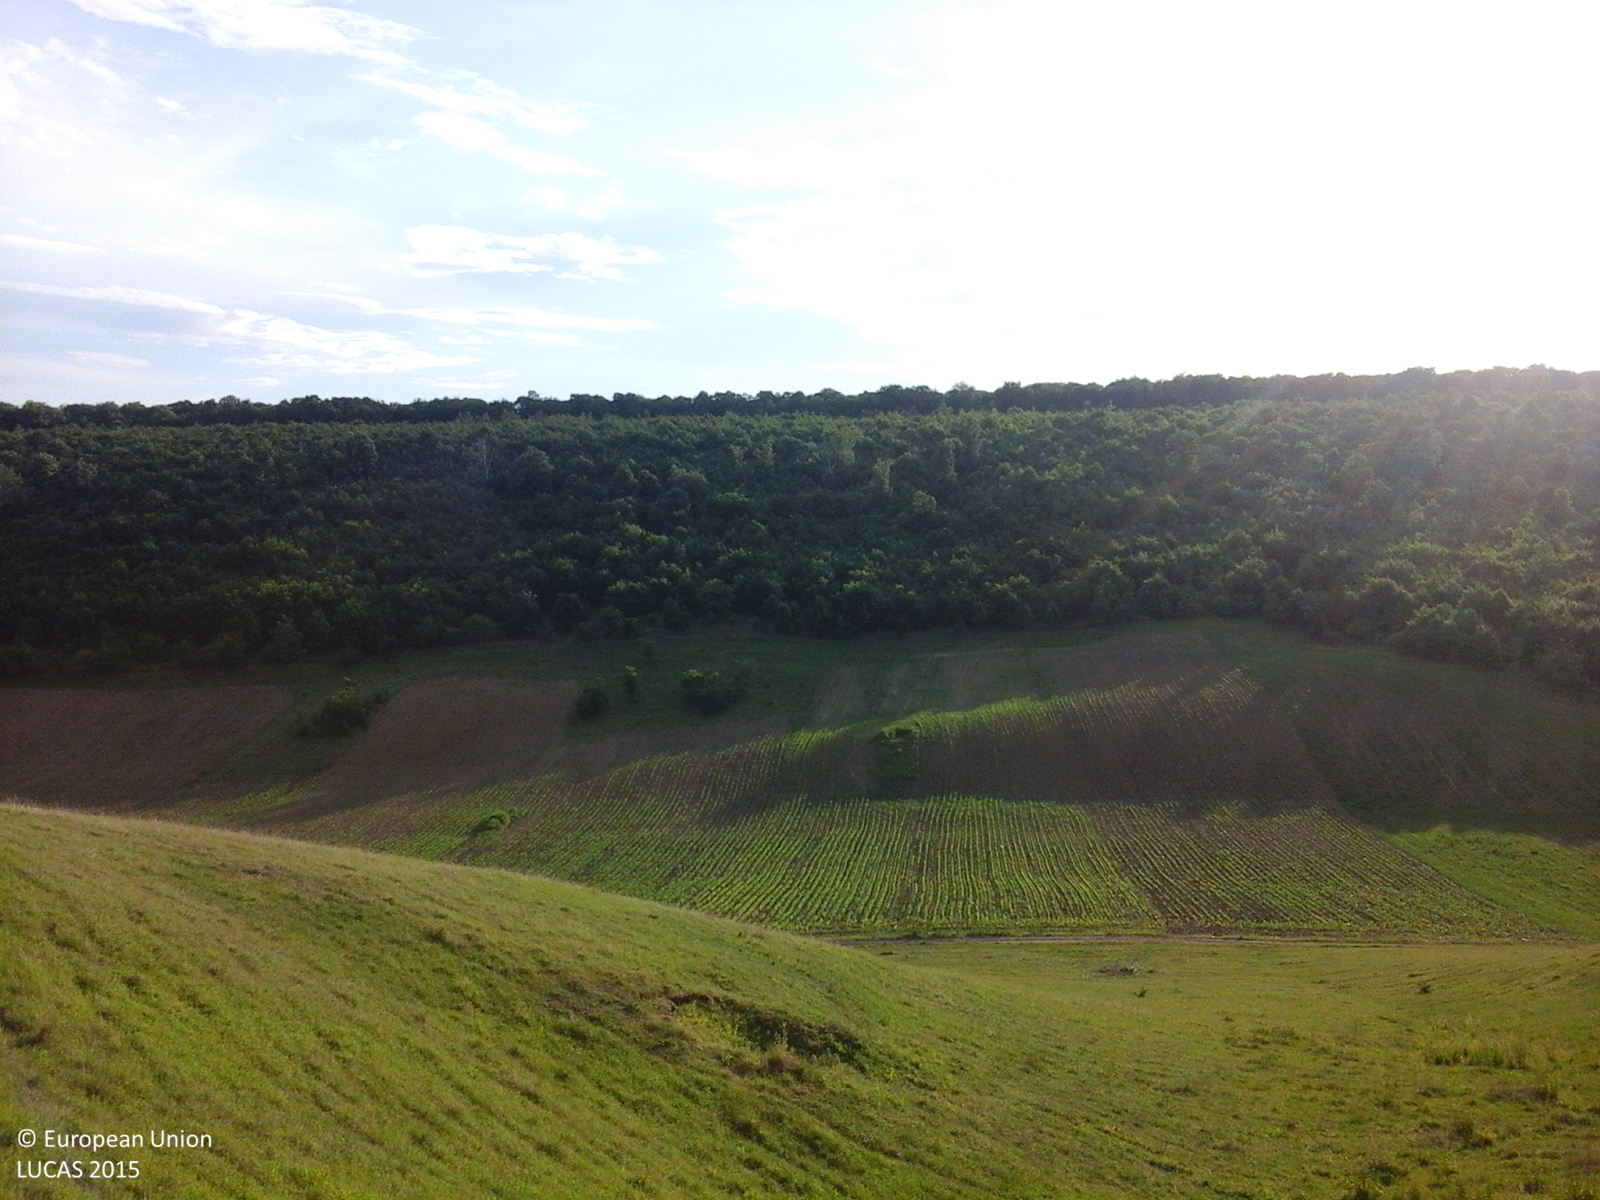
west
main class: Grassland
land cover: Grassland without tree/shrub cover
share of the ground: > 75 %
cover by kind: herbaceous plants 100 %
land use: Agriculture (excluding fallow land and kitchen gardens)
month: June
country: RO
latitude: 46.4221
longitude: 27.0510
